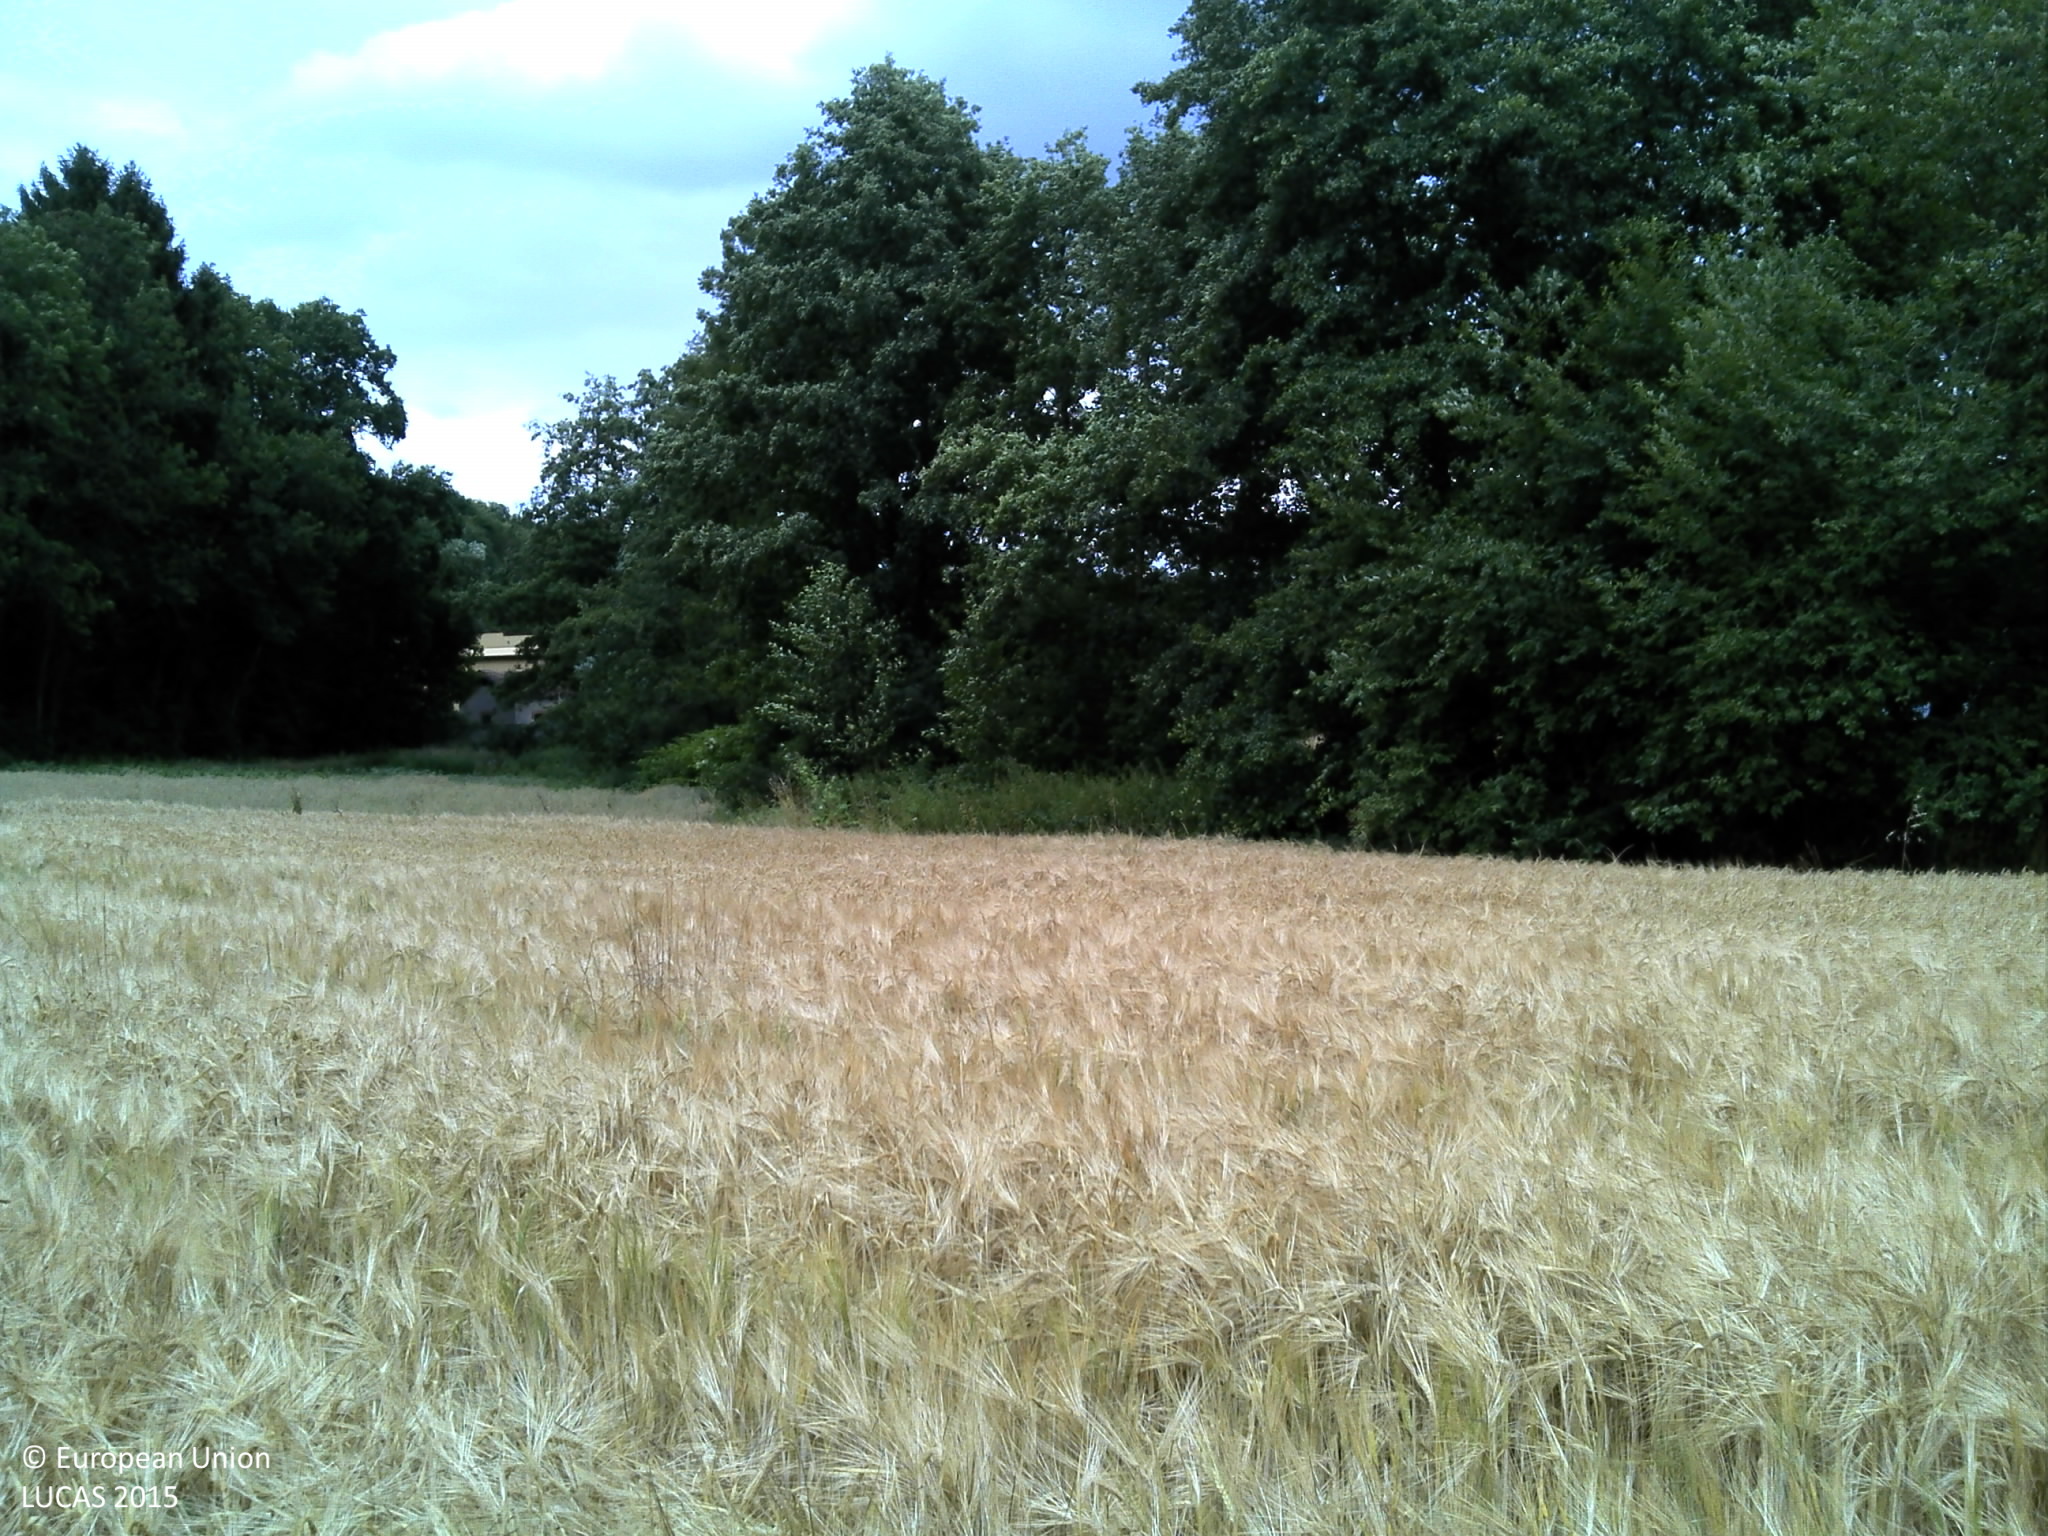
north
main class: Cropland
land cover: Rye
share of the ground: > 75 %
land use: Agriculture (excluding fallow land and kitchen gardens)
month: July
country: FR
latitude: 49.1862
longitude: 4.8798
